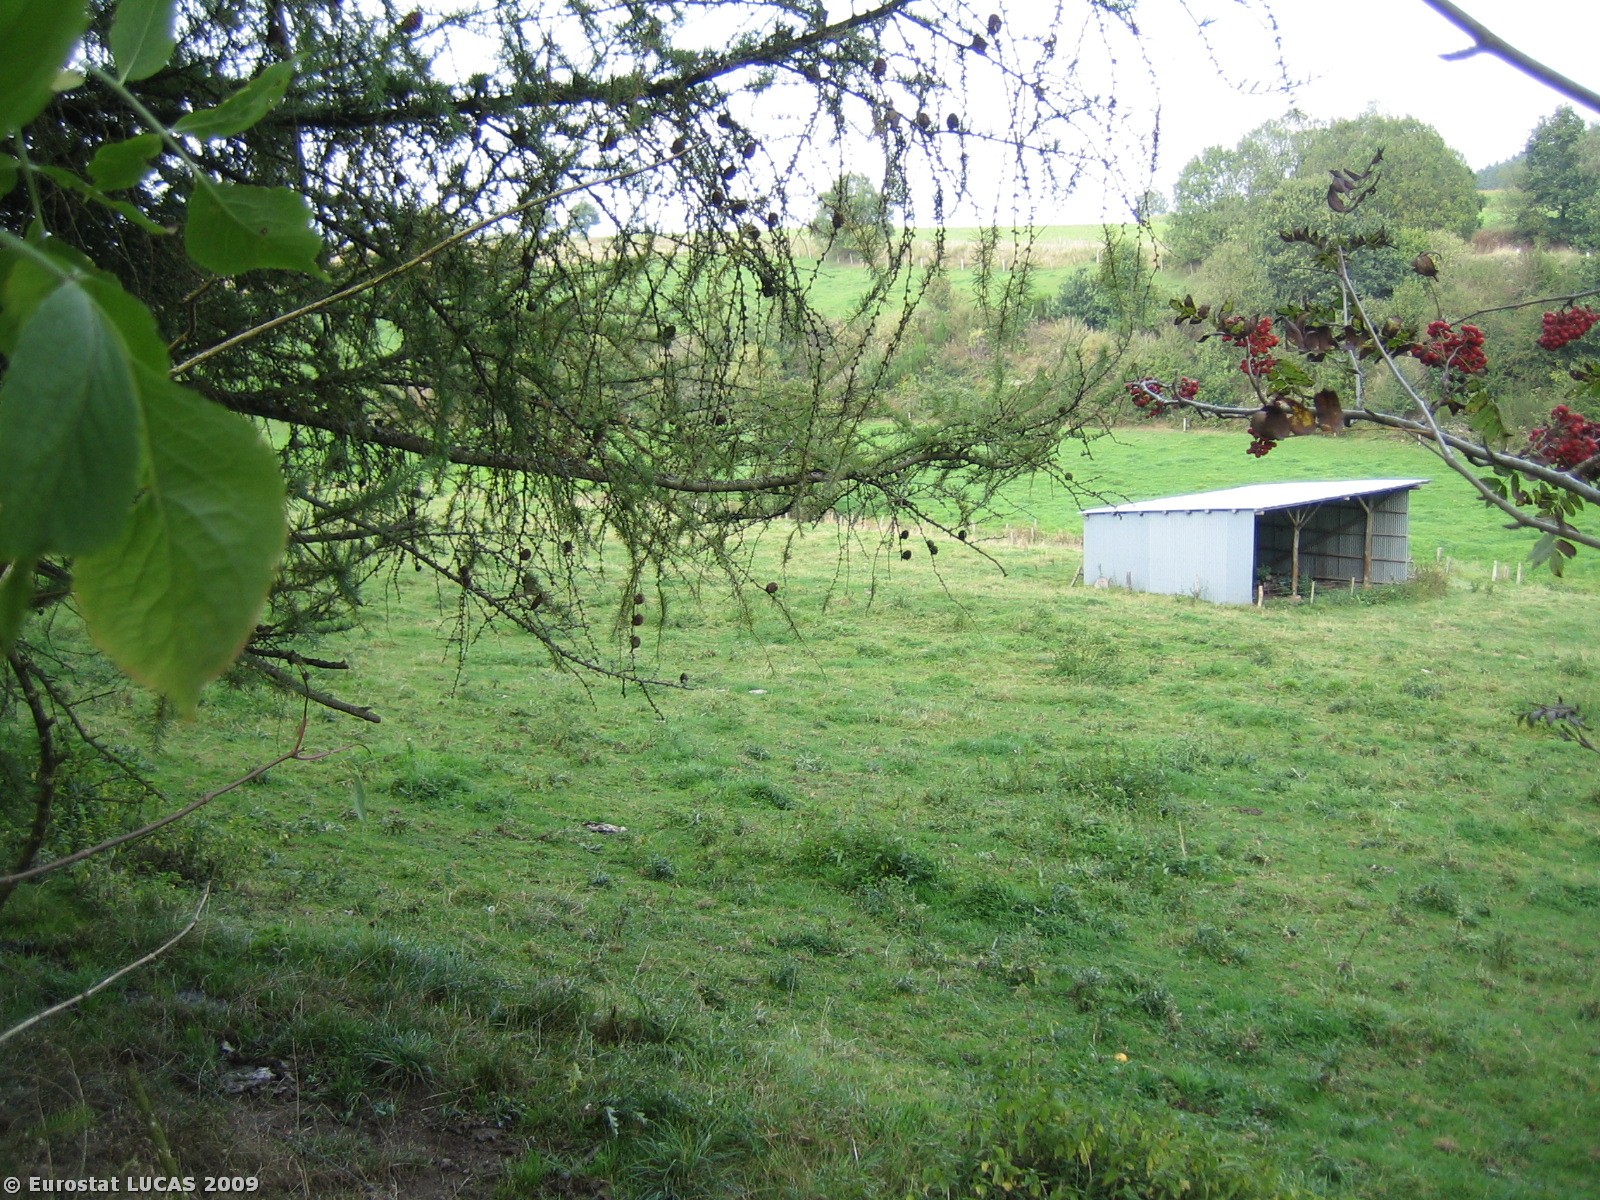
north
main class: Grassland
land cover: Grassland without tree/shrub cover
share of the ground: > 75 %
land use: Agriculture (excluding fallow land and kitchen gardens)
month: September
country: BE
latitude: 50.1182
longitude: 5.6210
